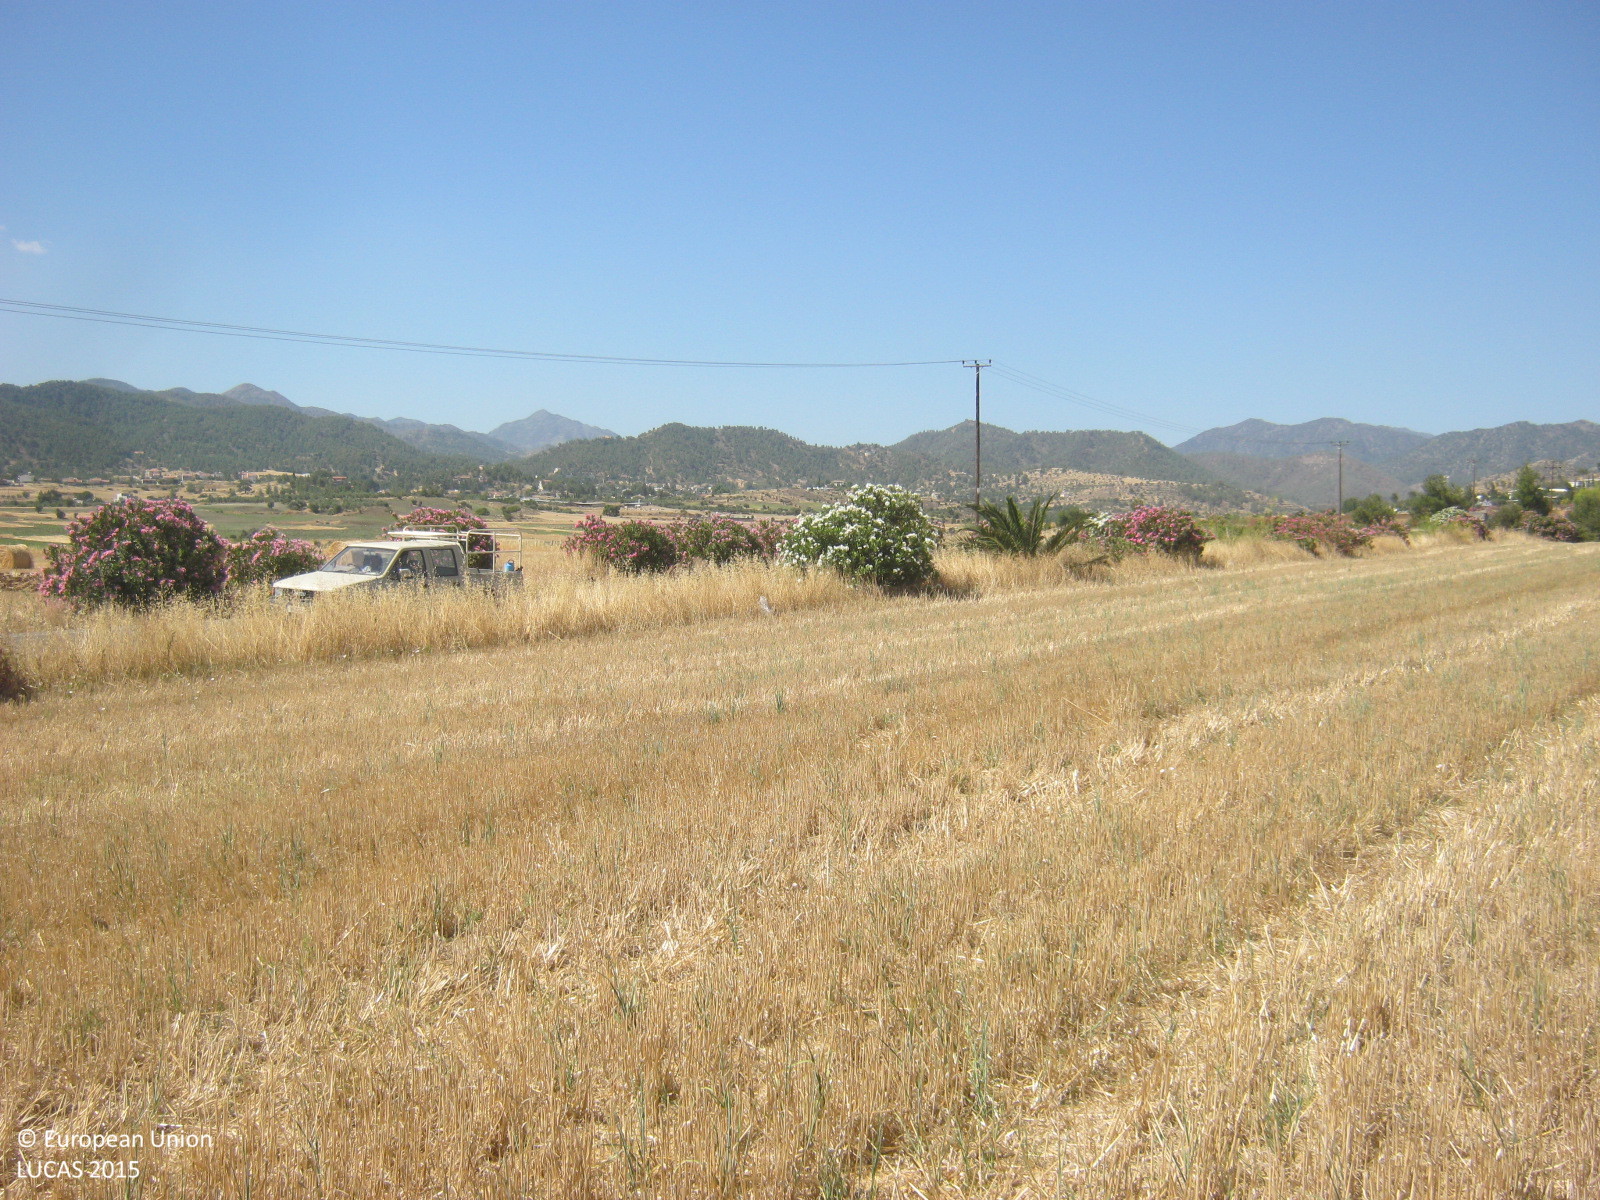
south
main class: Cropland
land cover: Barley
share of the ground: < 10 %
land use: Agriculture (excluding fallow land and kitchen gardens)
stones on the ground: < 10 %
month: June
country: CY
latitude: 35.0325
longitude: 33.1669
